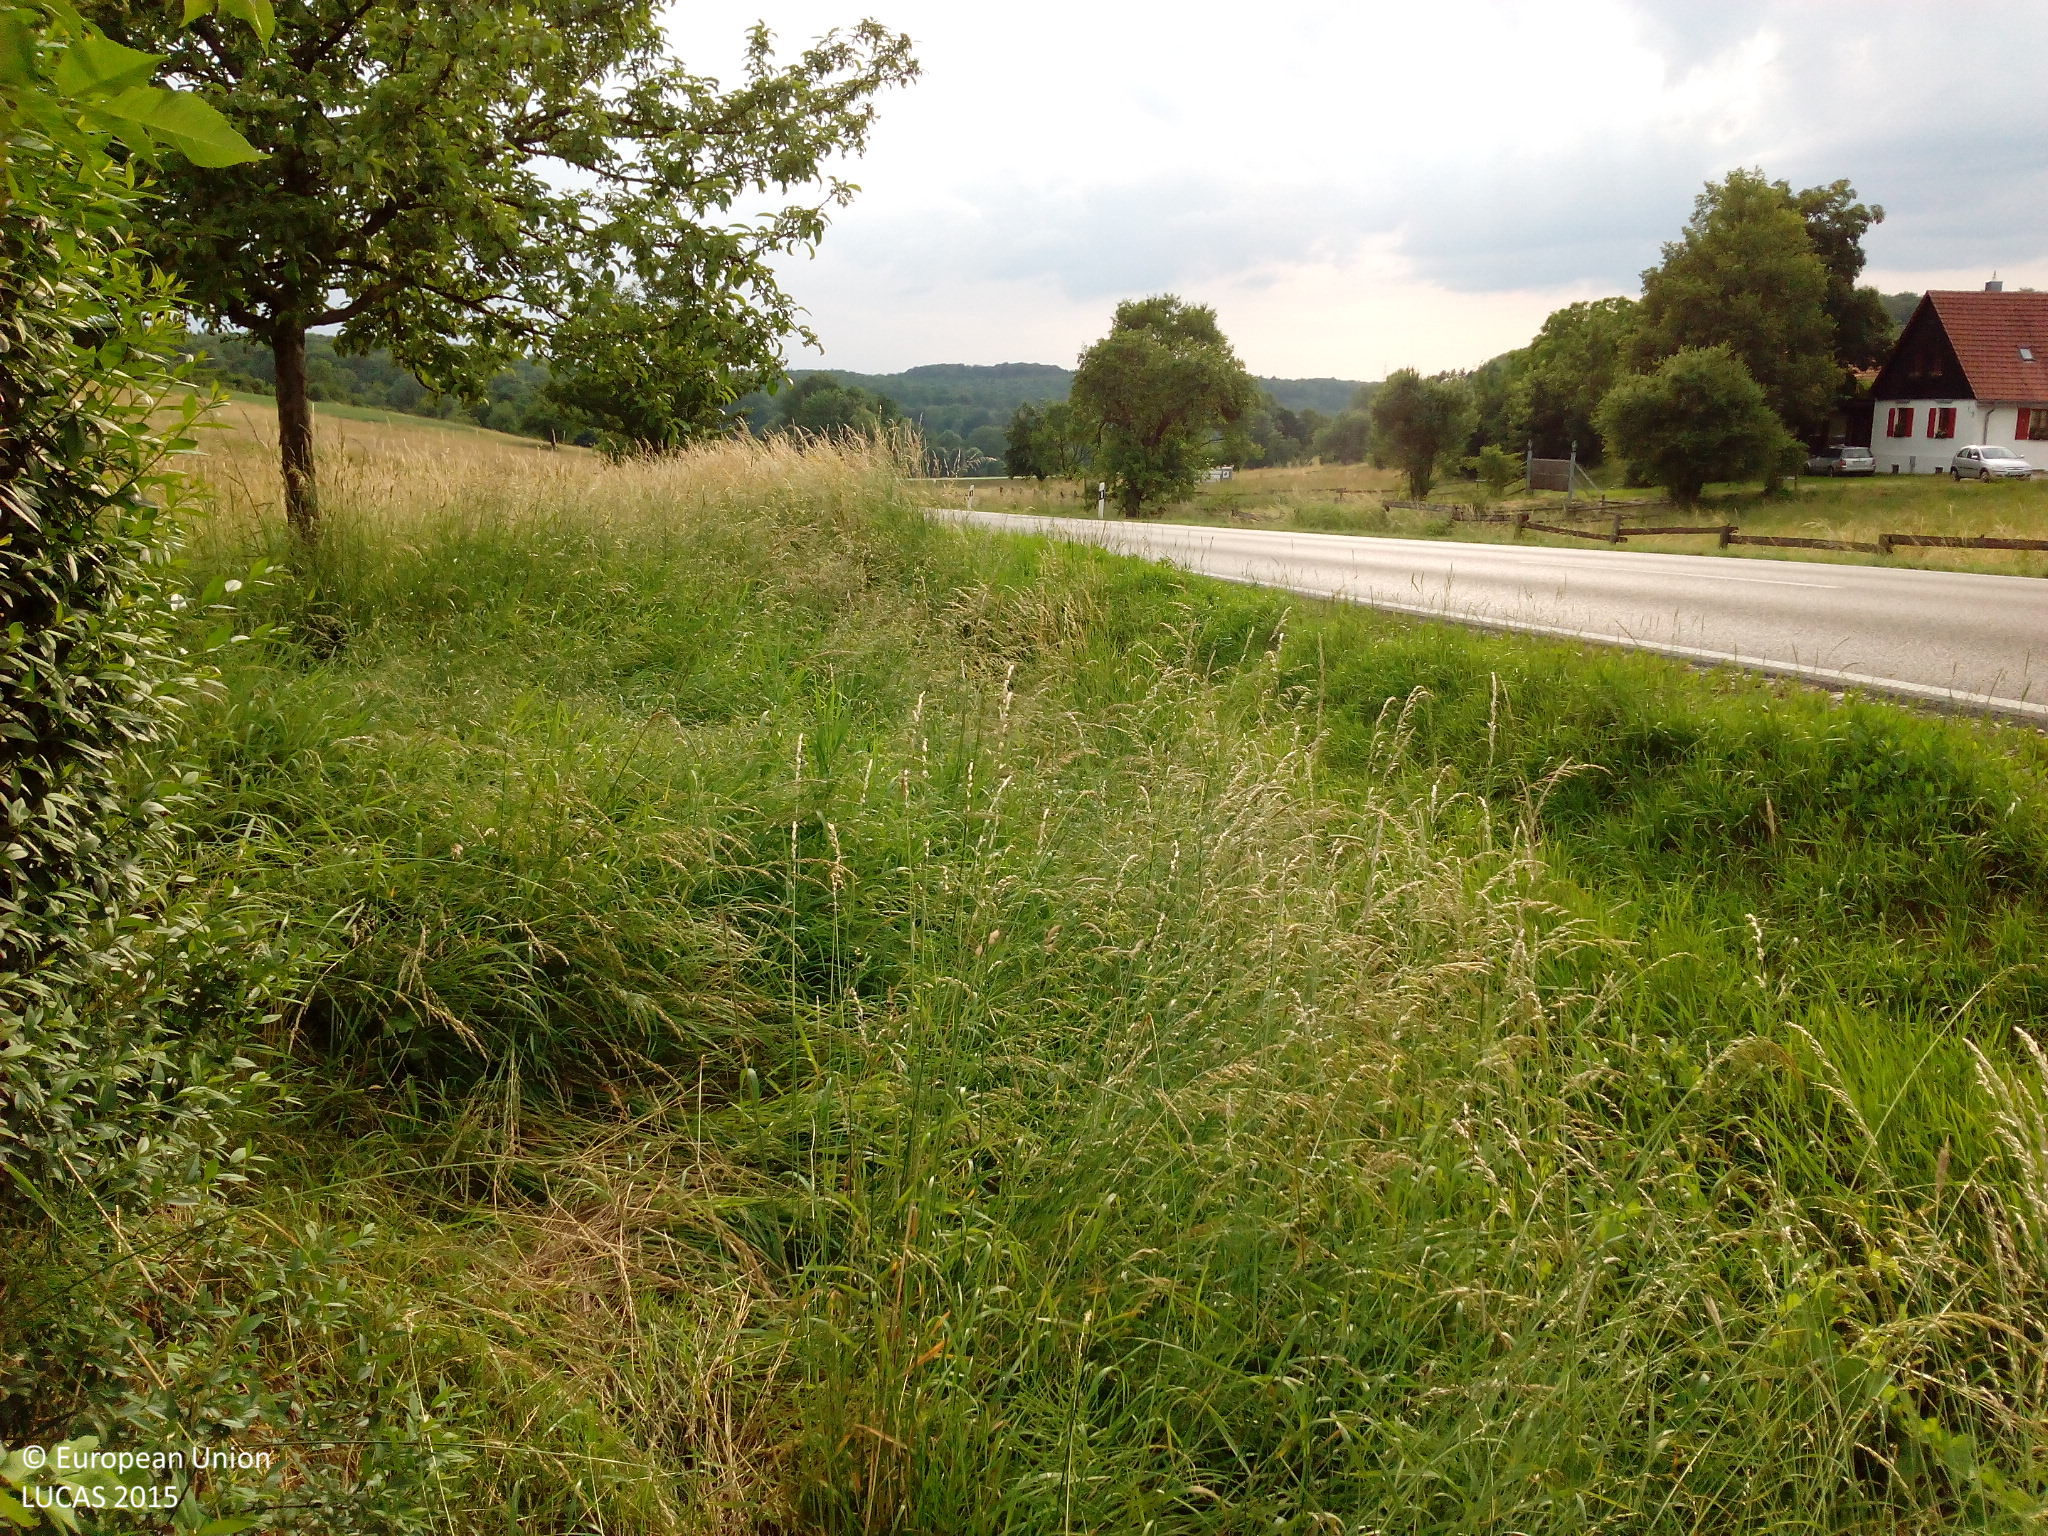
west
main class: Grassland
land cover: Grassland without tree/shrub cover
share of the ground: > 75 %
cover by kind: herbaceous plants 100 %
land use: Semi-natural and natural areas not in use
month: June
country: DE
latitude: 48.6358
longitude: 9.4168
